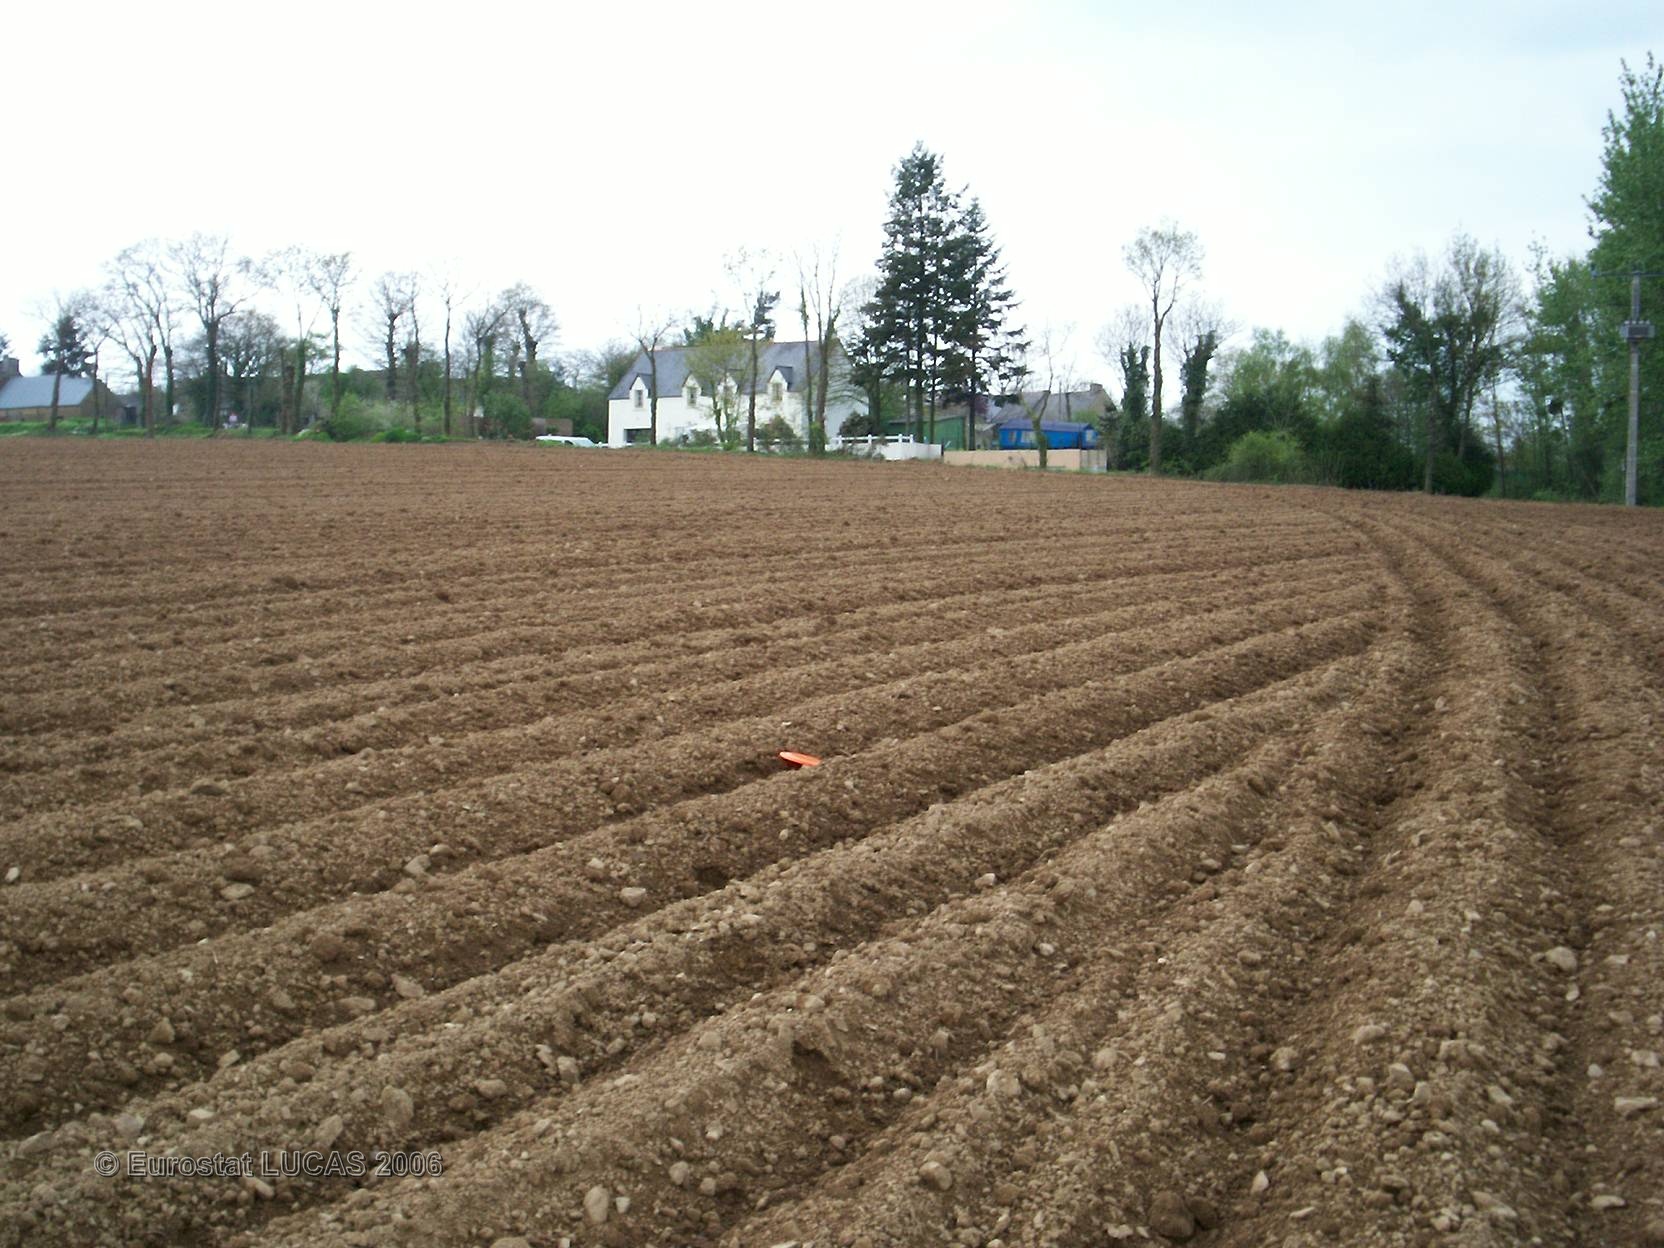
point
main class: Cropland
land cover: Maize
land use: Agriculture (excluding fallow land and kitchen gardens)
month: April
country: FR
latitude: 48.0112
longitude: -2.4046
